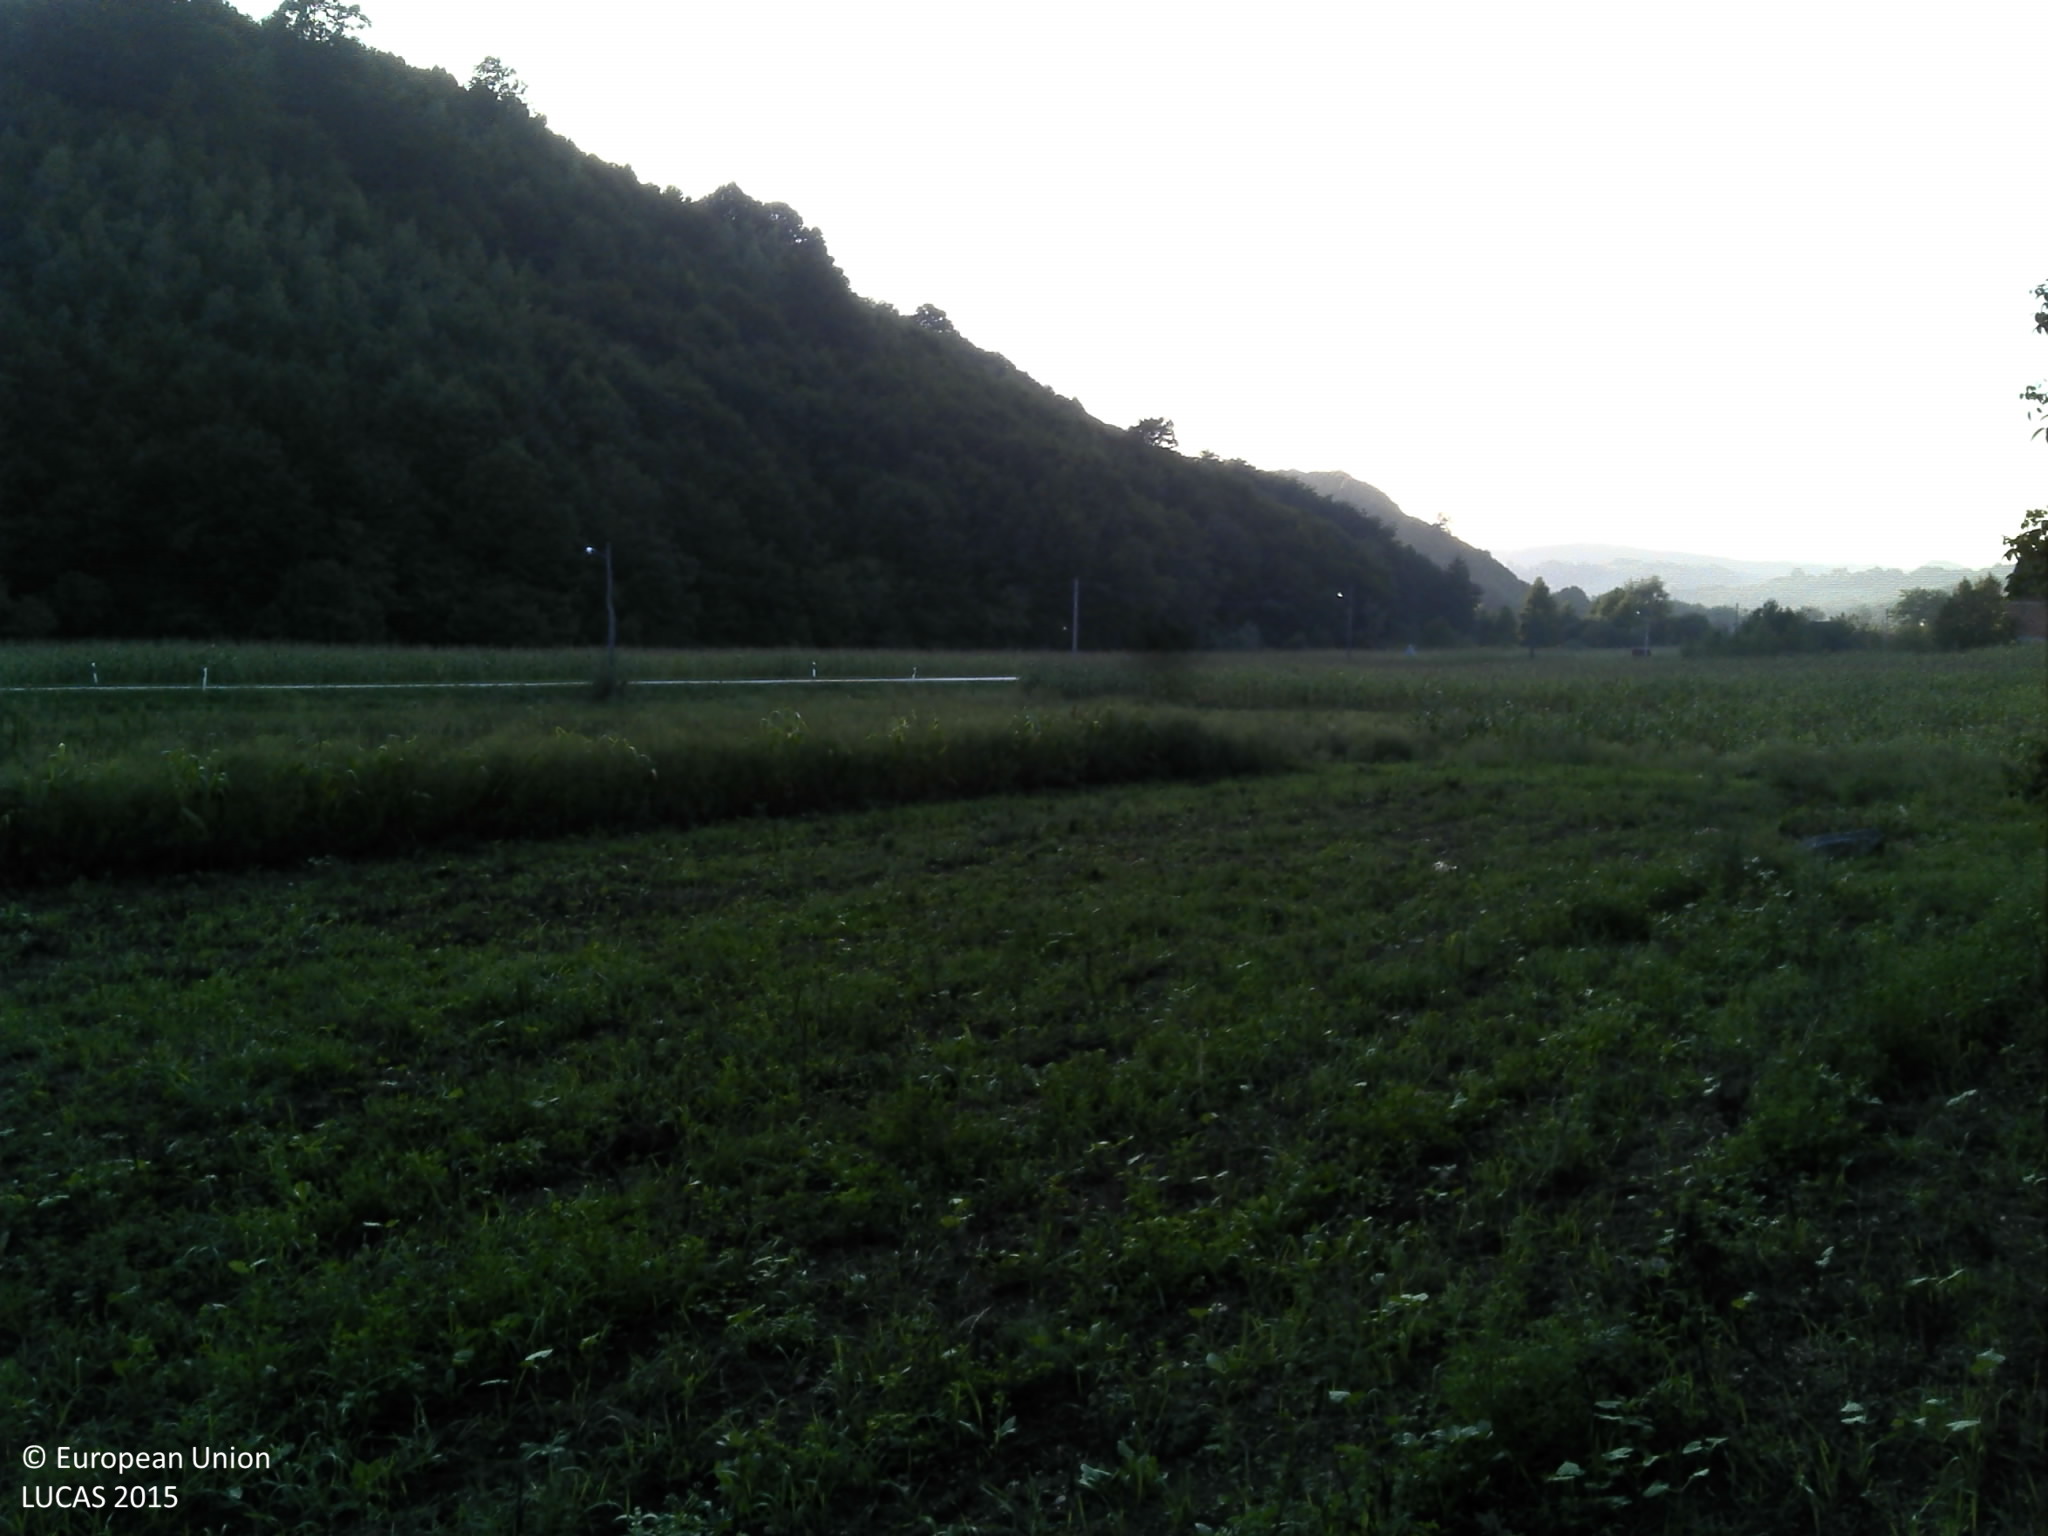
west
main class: Grassland
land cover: Grassland with sparse tree/shrub cover
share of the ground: > 75 %
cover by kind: herbaceous plants 90 %, broadleaved forest trees 5 %, shrubs 5 %
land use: Residential
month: August
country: HR
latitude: 45.2605
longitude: 15.6923
